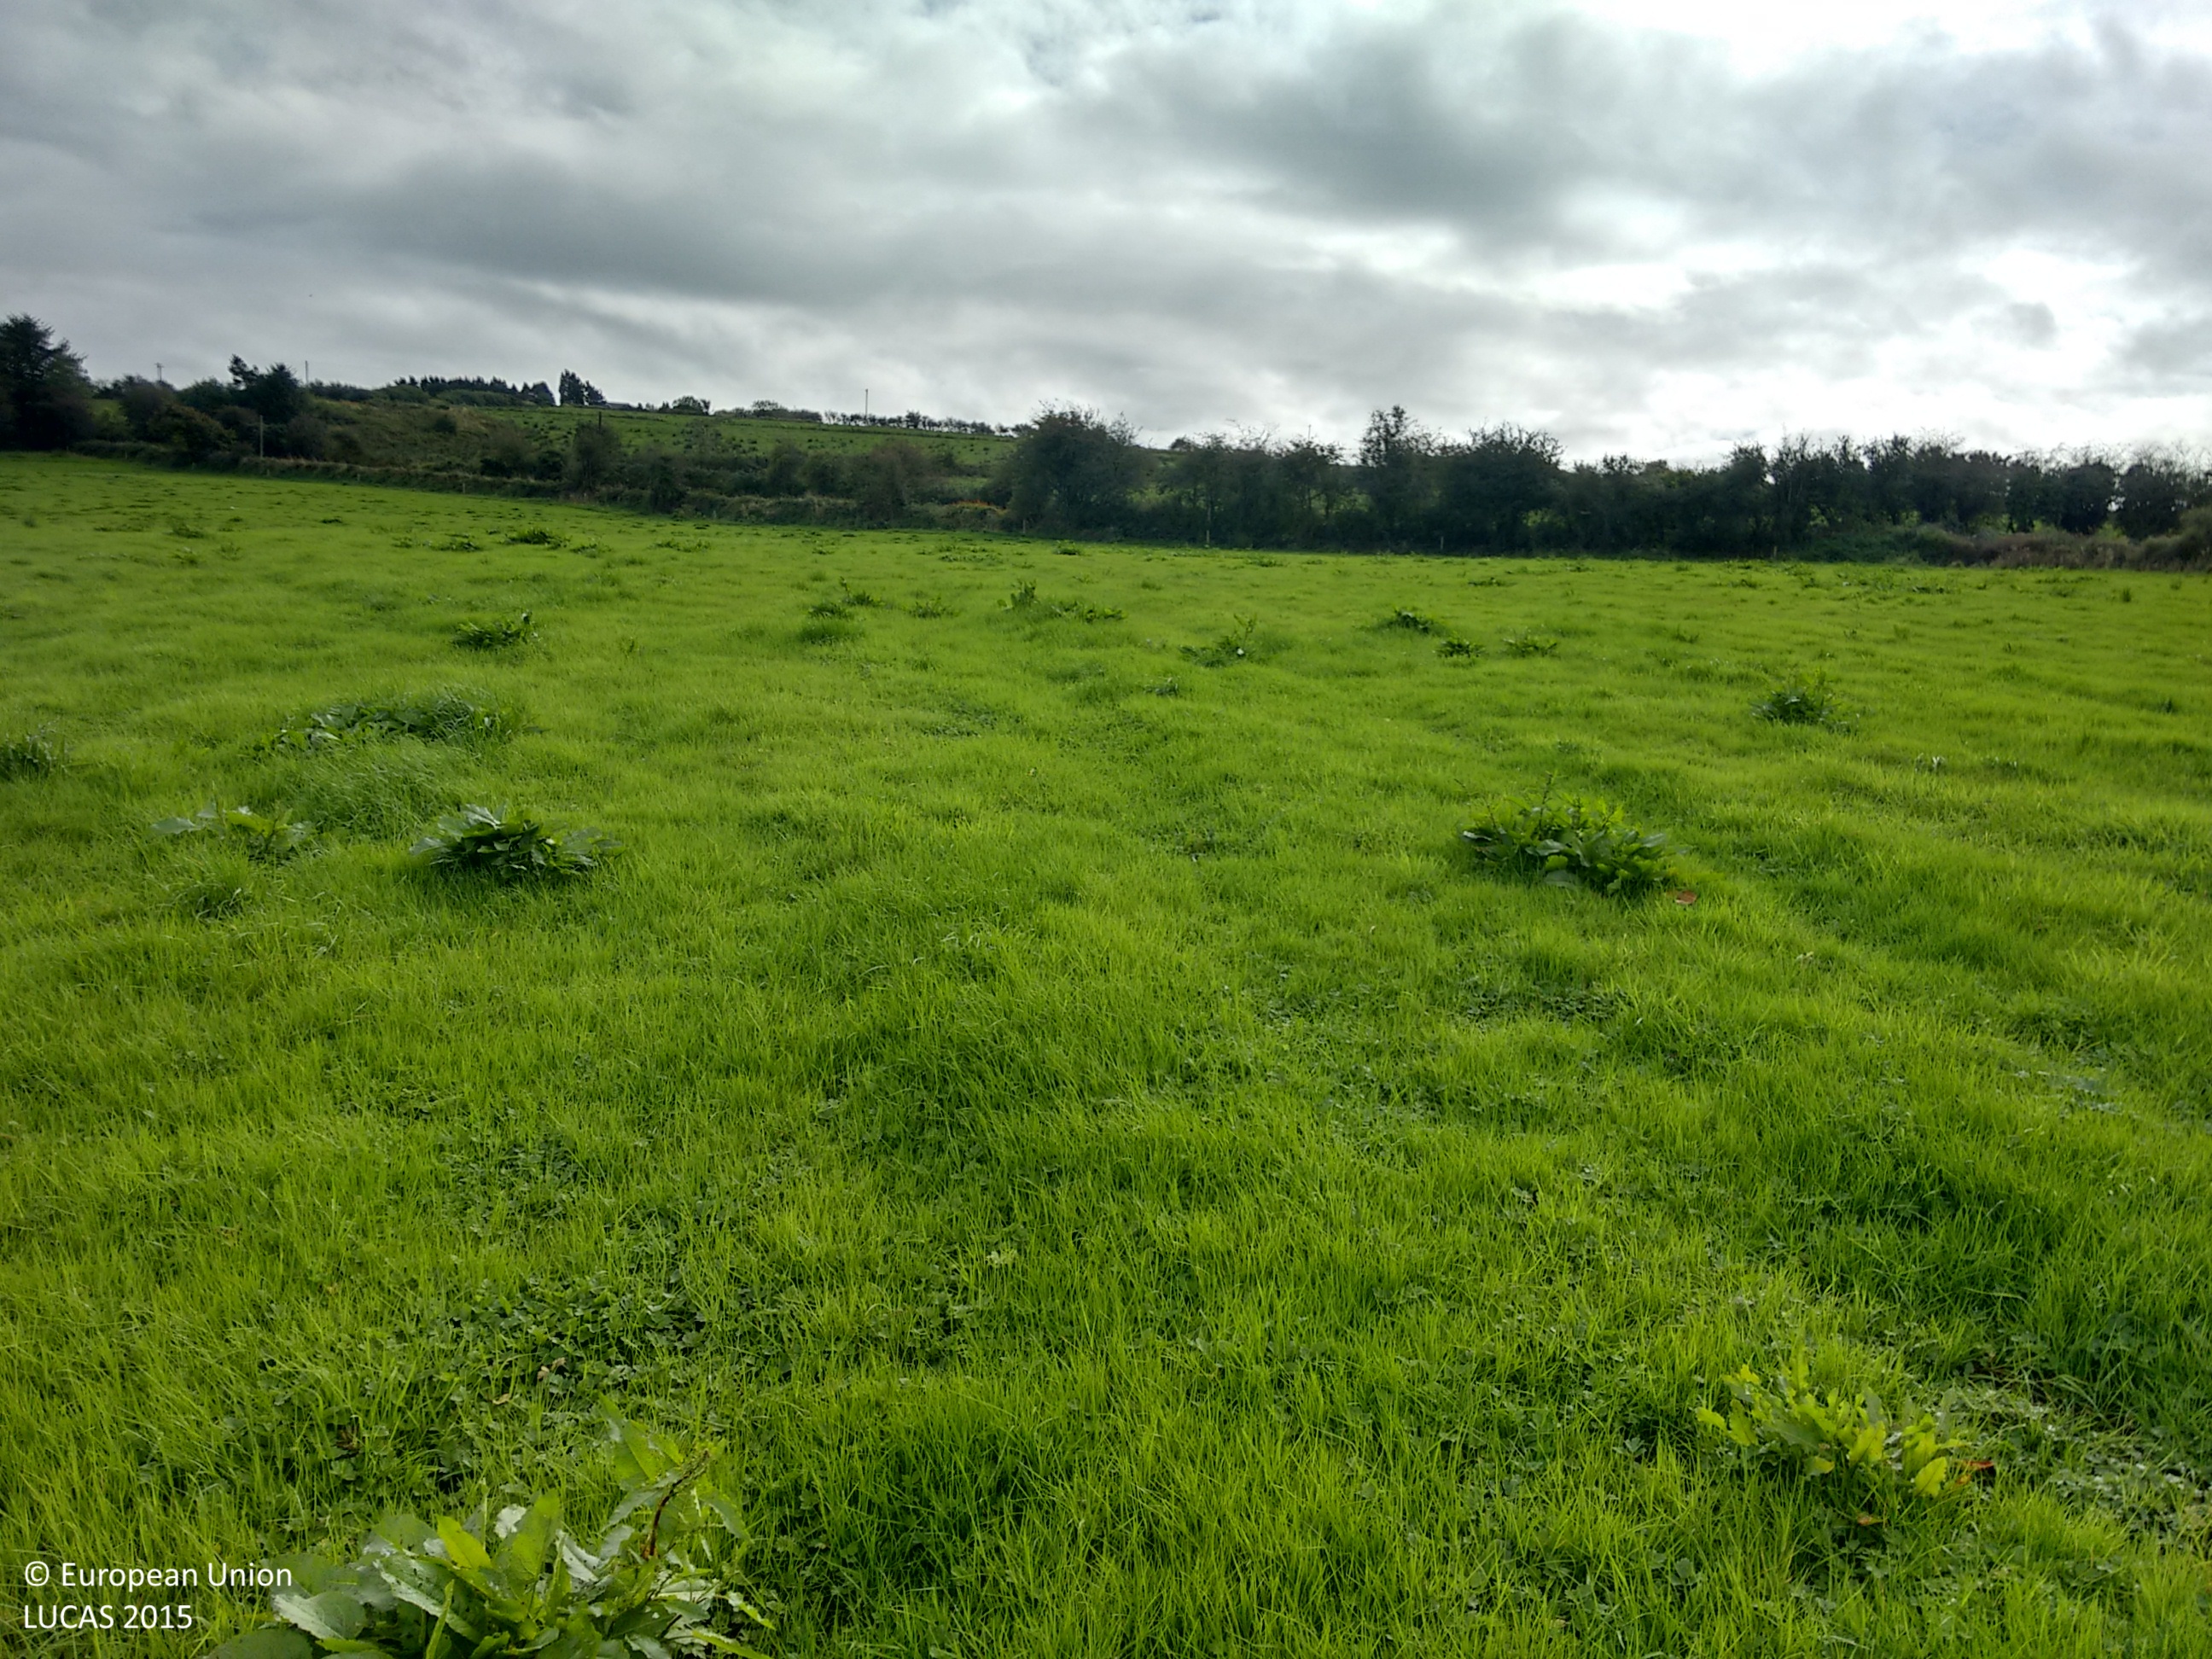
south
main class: Grassland
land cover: Grassland without tree/shrub cover
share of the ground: > 75 %
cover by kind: herbaceous plants 95 %, shrubs 5 %
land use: Agriculture (excluding fallow land and kitchen gardens)
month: September
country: IE
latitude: 52.3728
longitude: -9.2441
